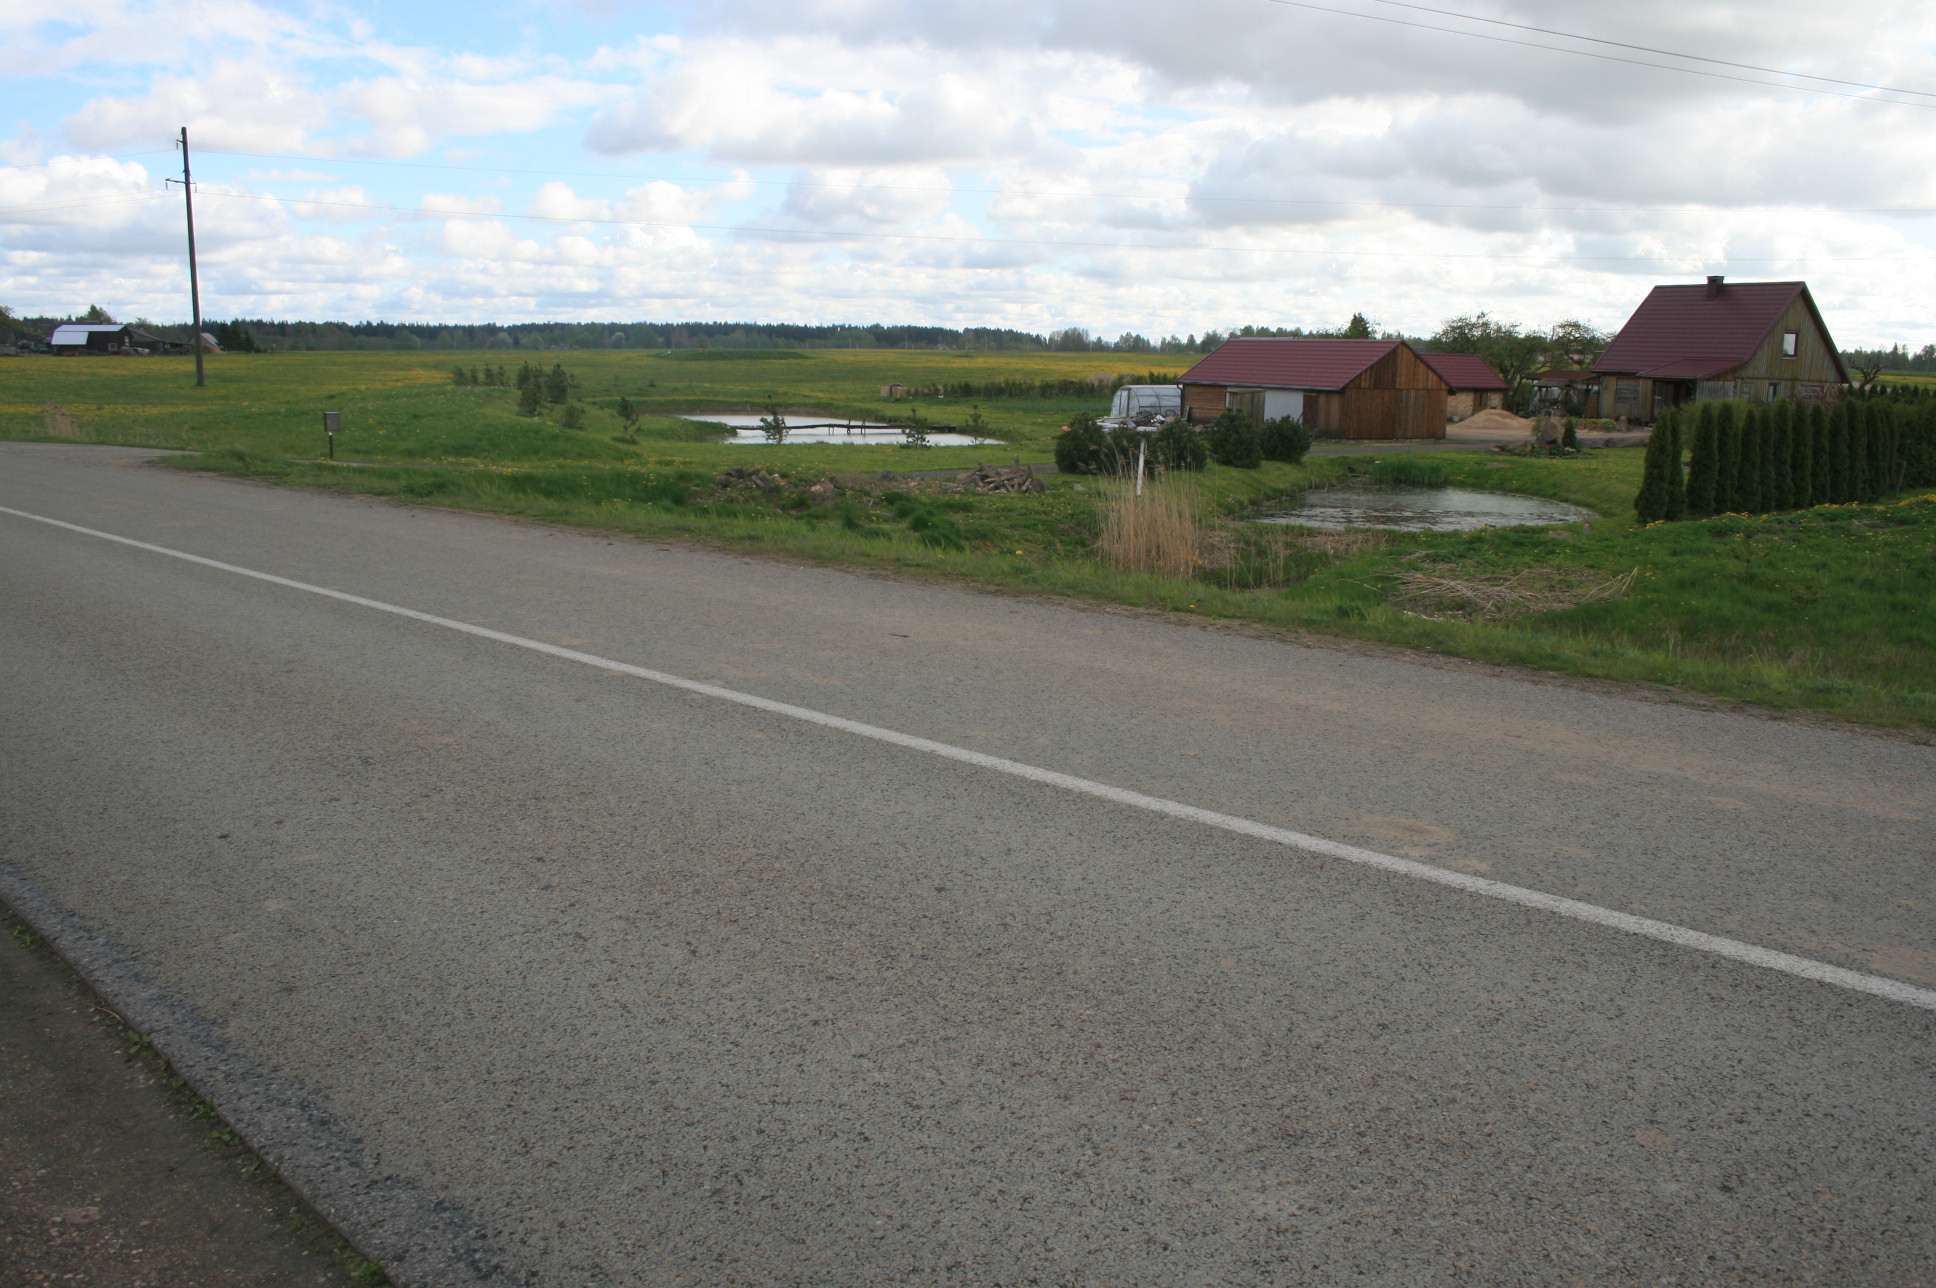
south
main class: Grassland
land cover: Grassland without tree/shrub cover
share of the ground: > 75 %
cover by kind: herbaceous plants 100 %
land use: Agriculture (excluding fallow land and kitchen gardens)
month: May
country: LT
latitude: 56.1606
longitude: 22.0799
